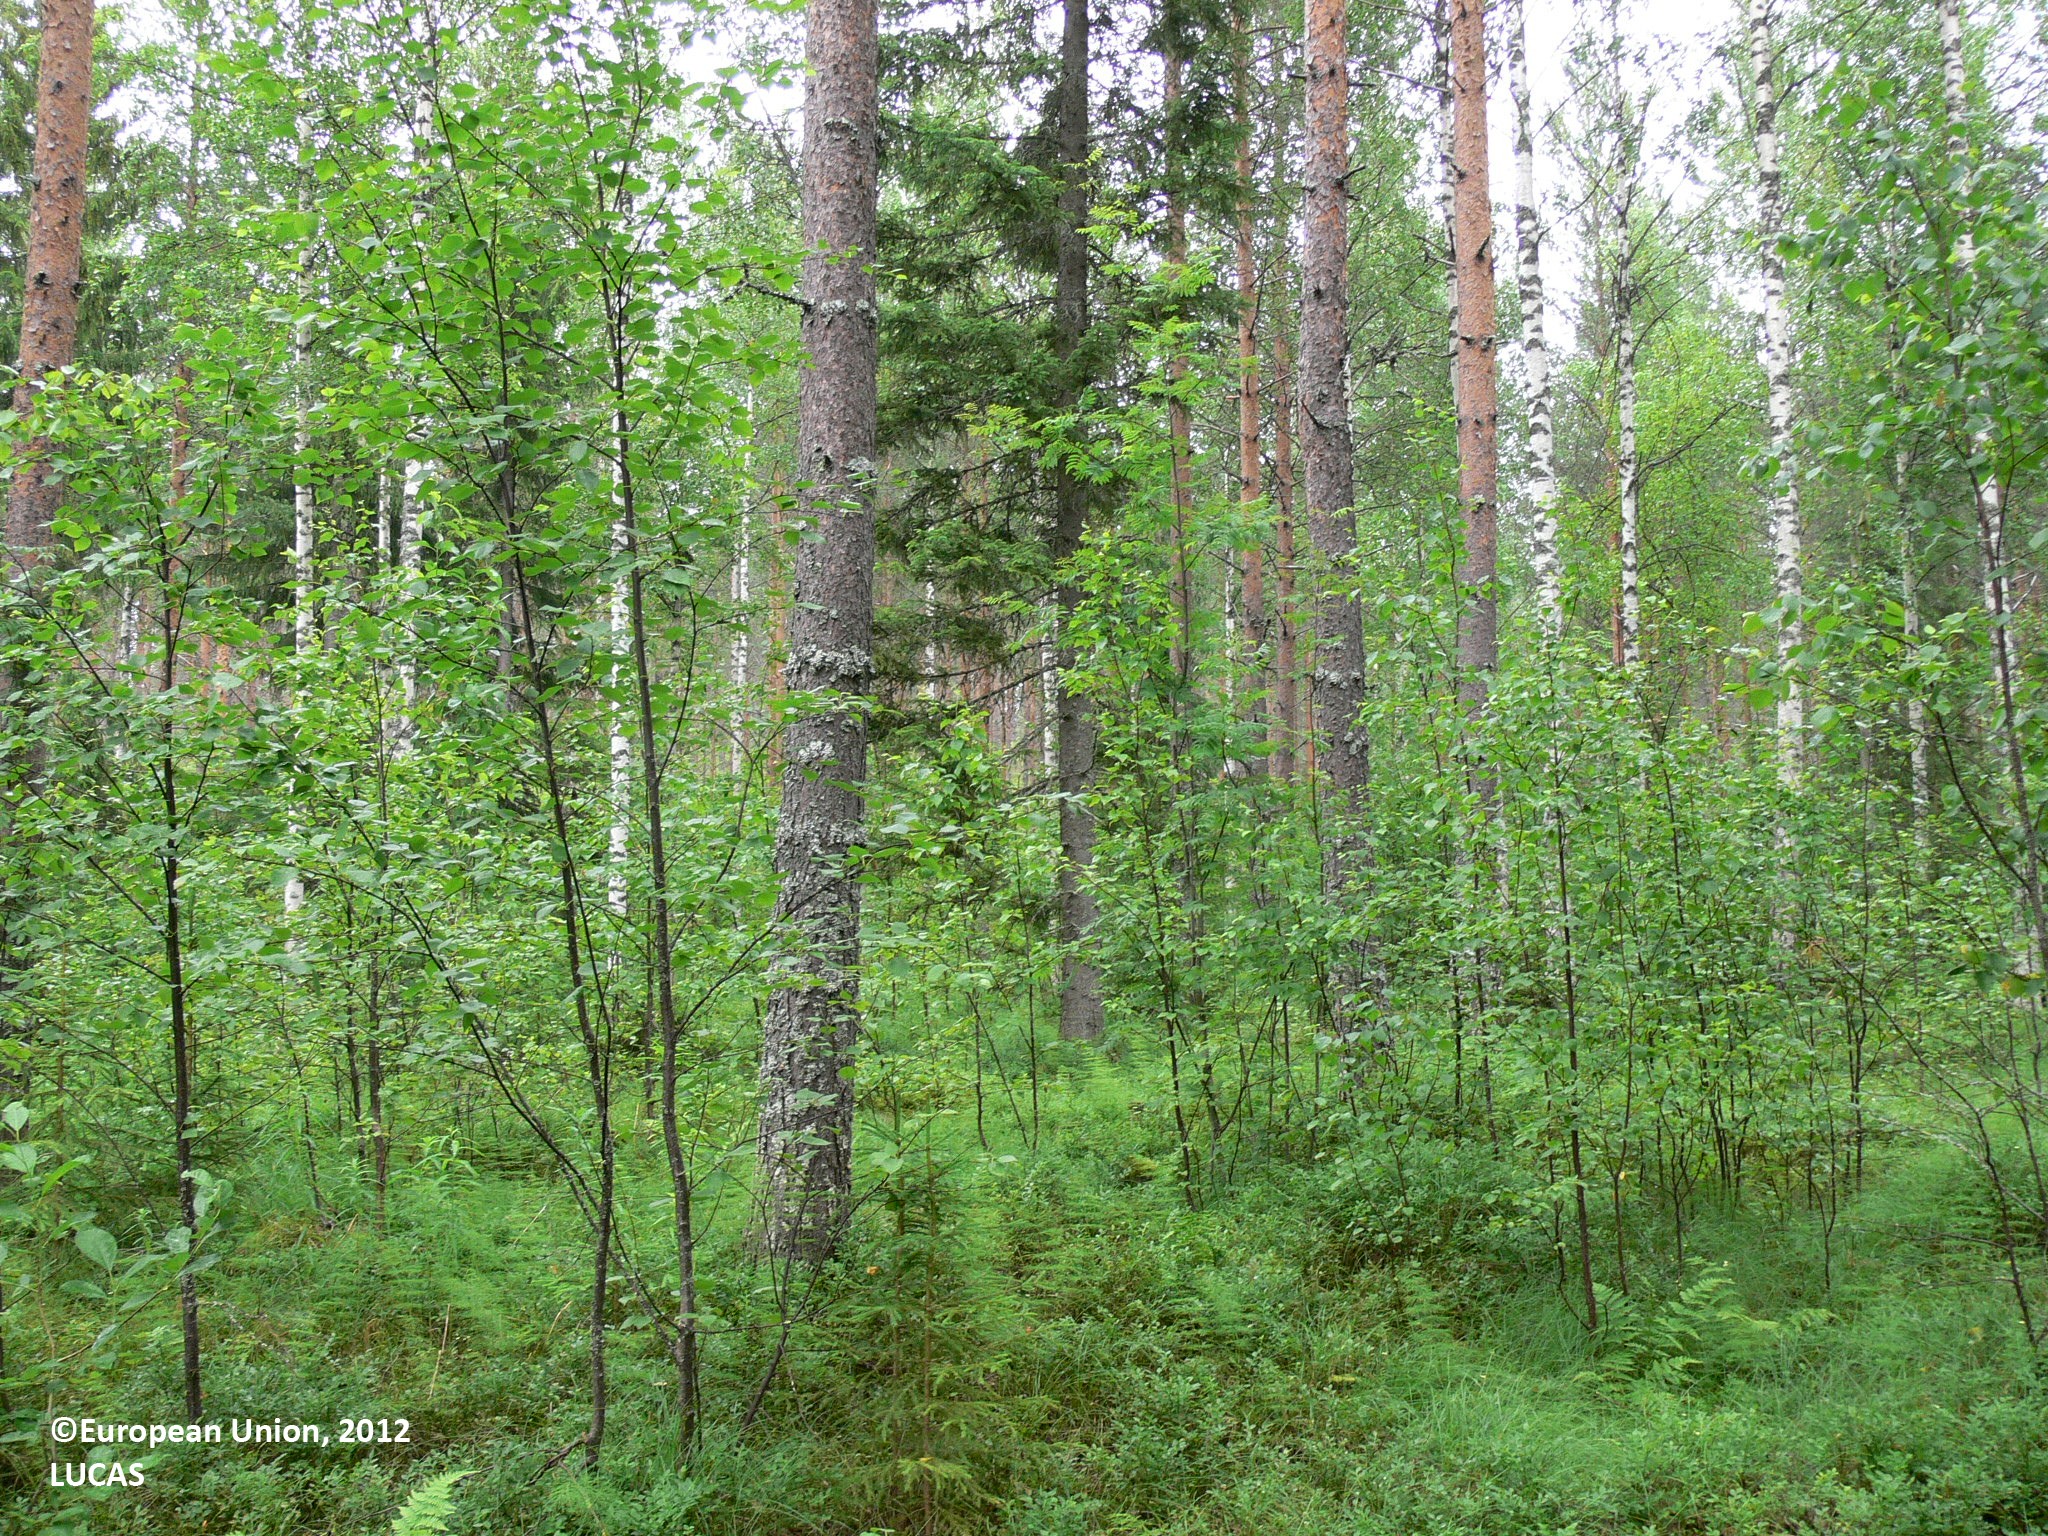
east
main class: Woodland
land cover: Other mixed woodland
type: boreal forest
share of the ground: > 75 %
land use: Forestry
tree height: > 5 m
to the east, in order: Other mixed woodland; Ditches and canals; Pine dominated coniferous woodland; Ditches and canals; Pine dominated coniferous woodland; Ditches and canals; Pine dominated coniferous woodland
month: July
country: FI
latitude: 63.2301
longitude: 30.8464
